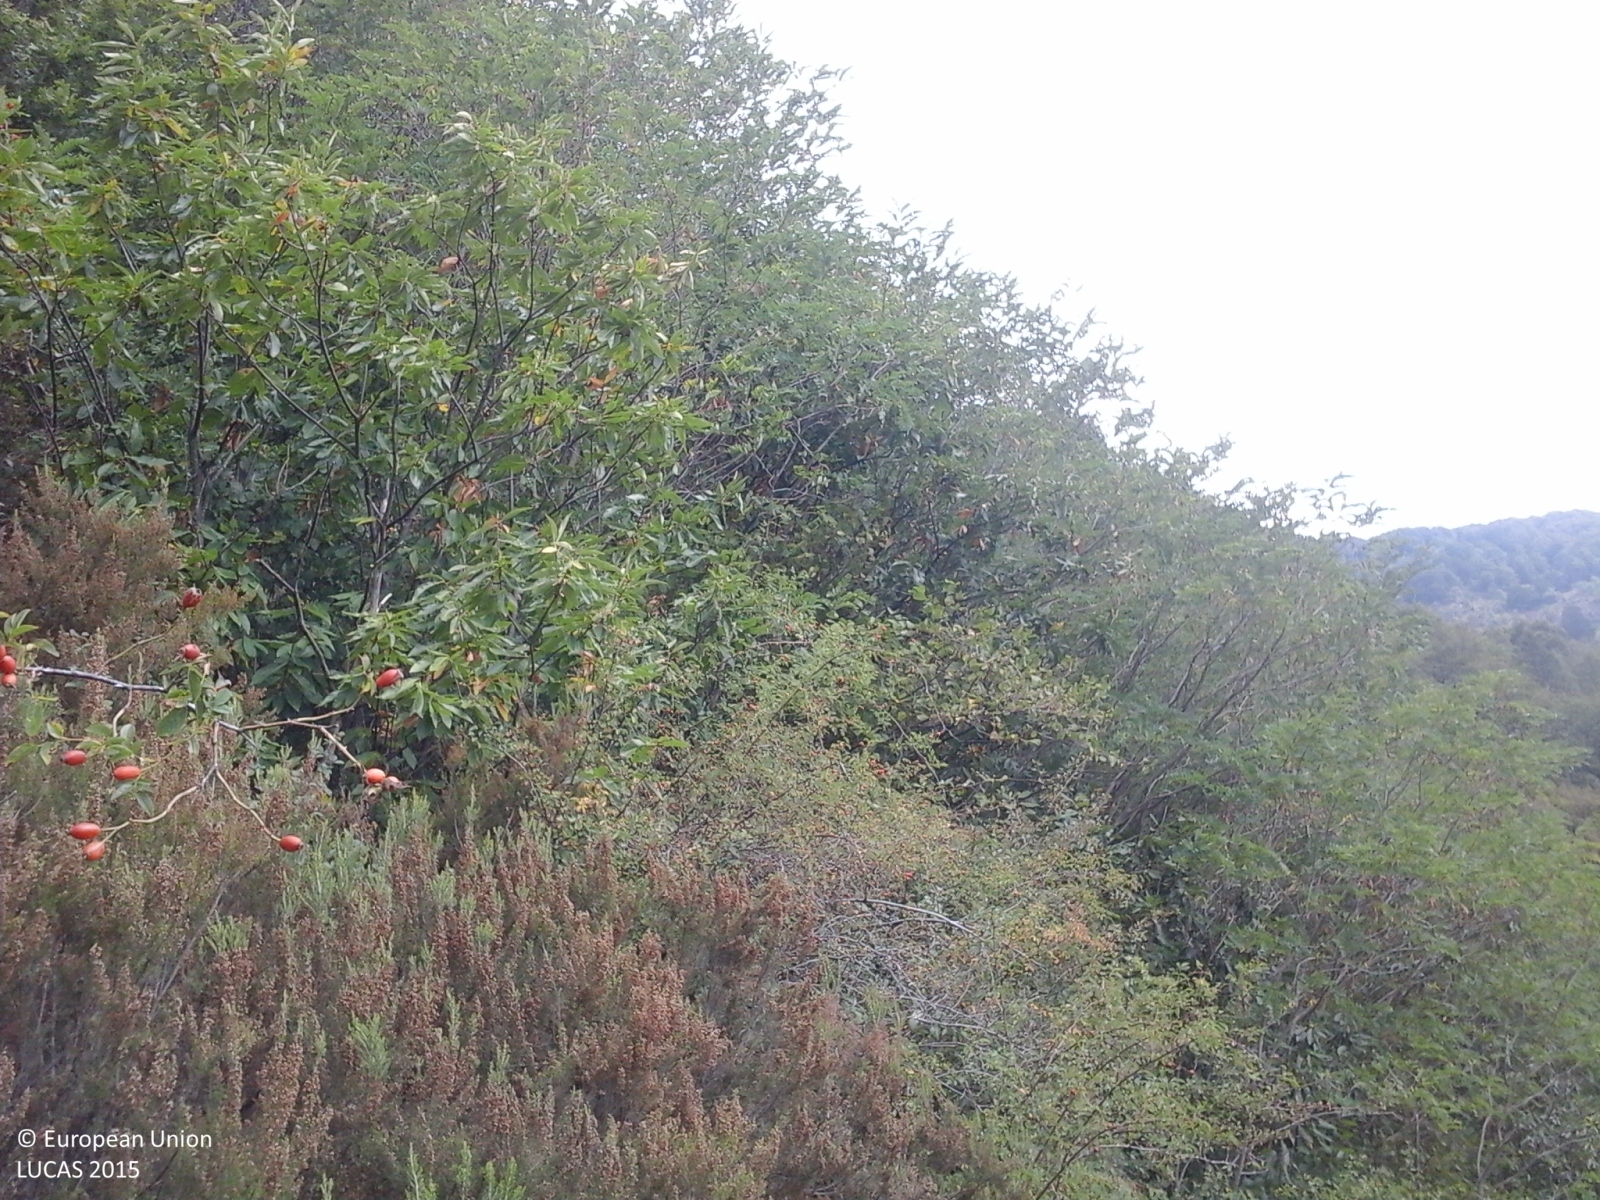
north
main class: Woodland
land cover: Broadleaved woodland
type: thermophilous deciduous forest
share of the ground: > 75 %
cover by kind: broadleaved forest trees 100 %
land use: Forestry
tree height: > 5 m
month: September
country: IT
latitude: 44.4558
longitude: 9.2100
